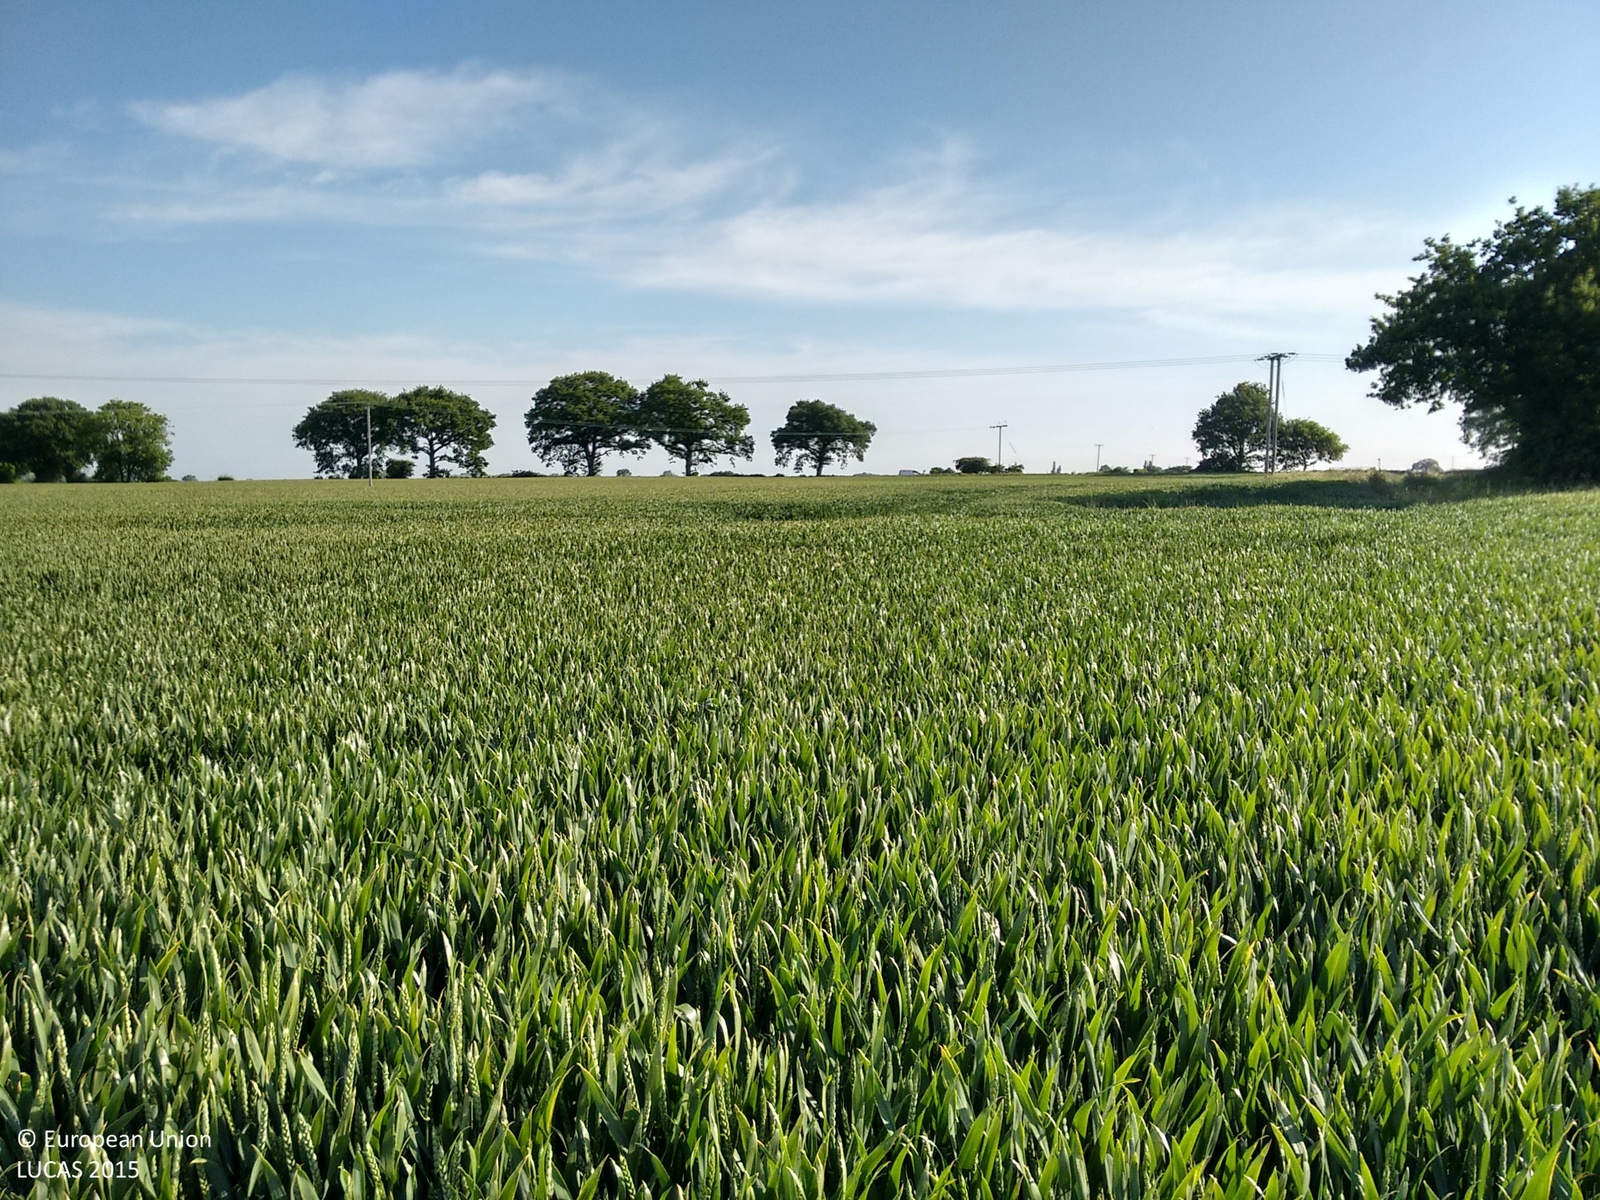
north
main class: Cropland
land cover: Common wheat
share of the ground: > 75 %
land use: Agriculture (excluding fallow land and kitchen gardens)
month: June
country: GB
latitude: 53.7993
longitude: -1.0818
